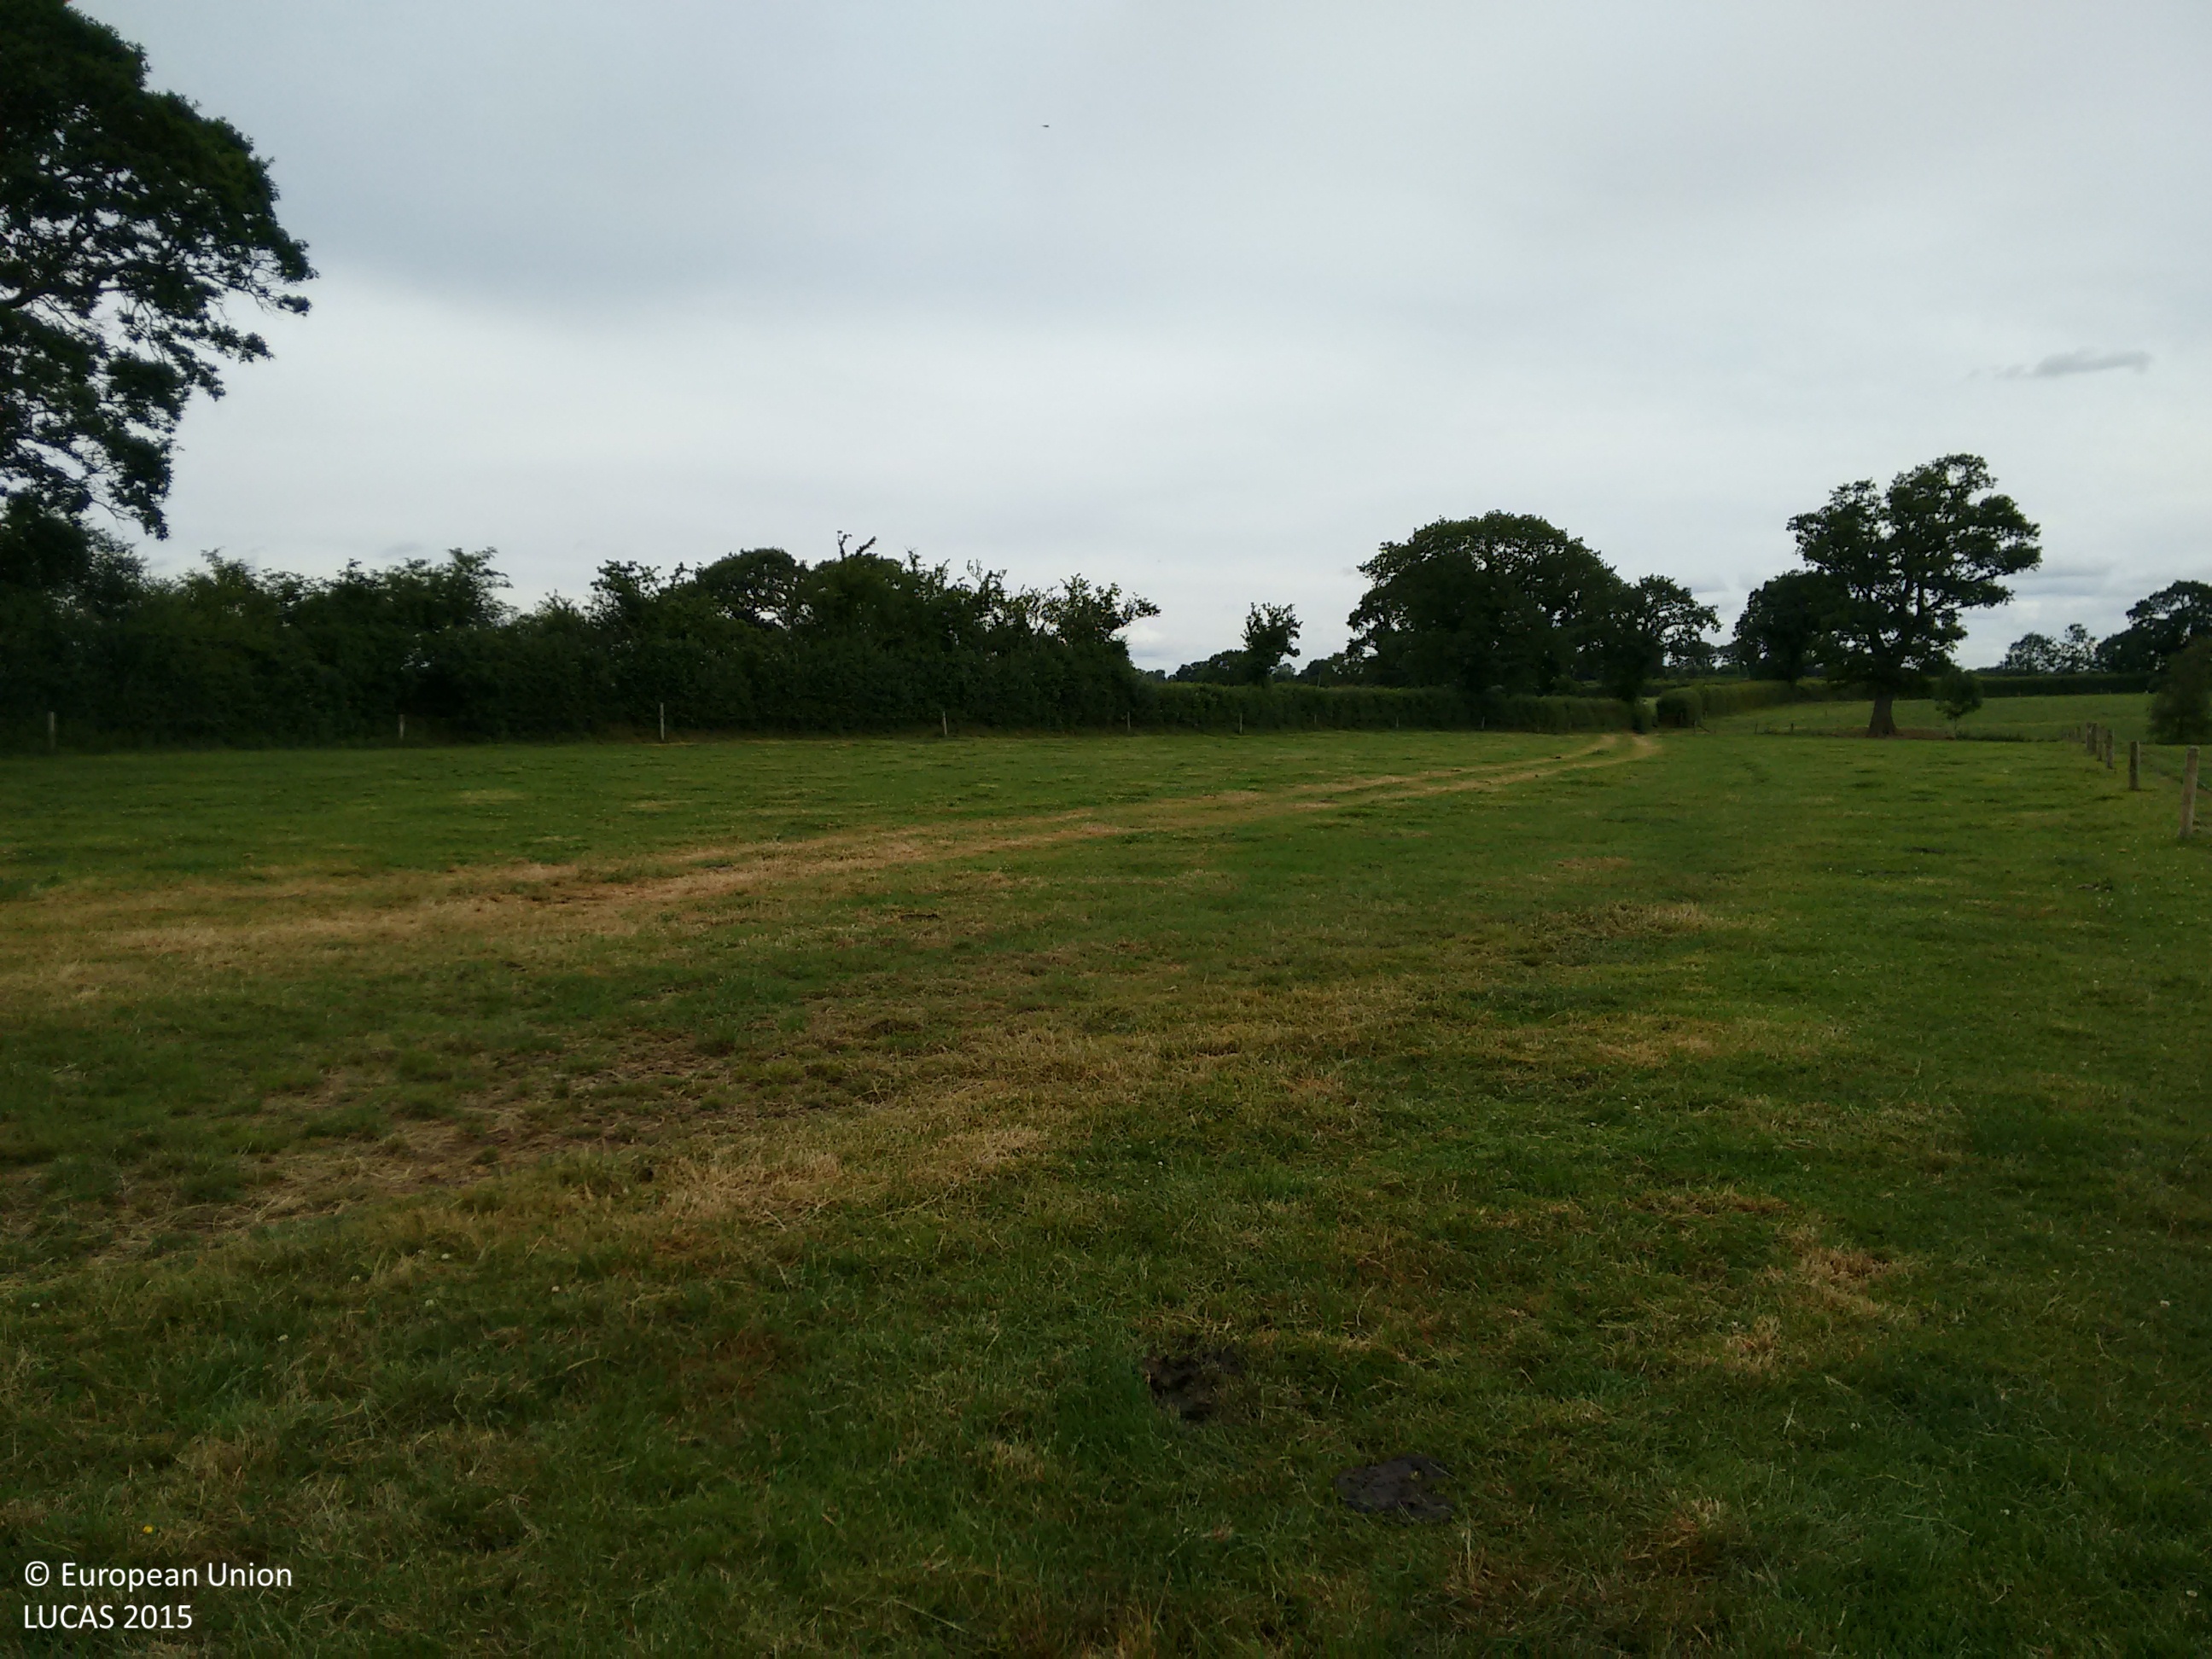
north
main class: Grassland
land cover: Grassland without tree/shrub cover
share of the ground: > 75 %
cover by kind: herbaceous plants 100 %
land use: Agriculture (excluding fallow land and kitchen gardens)
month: July
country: IE
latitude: 52.5387
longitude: -7.3603
